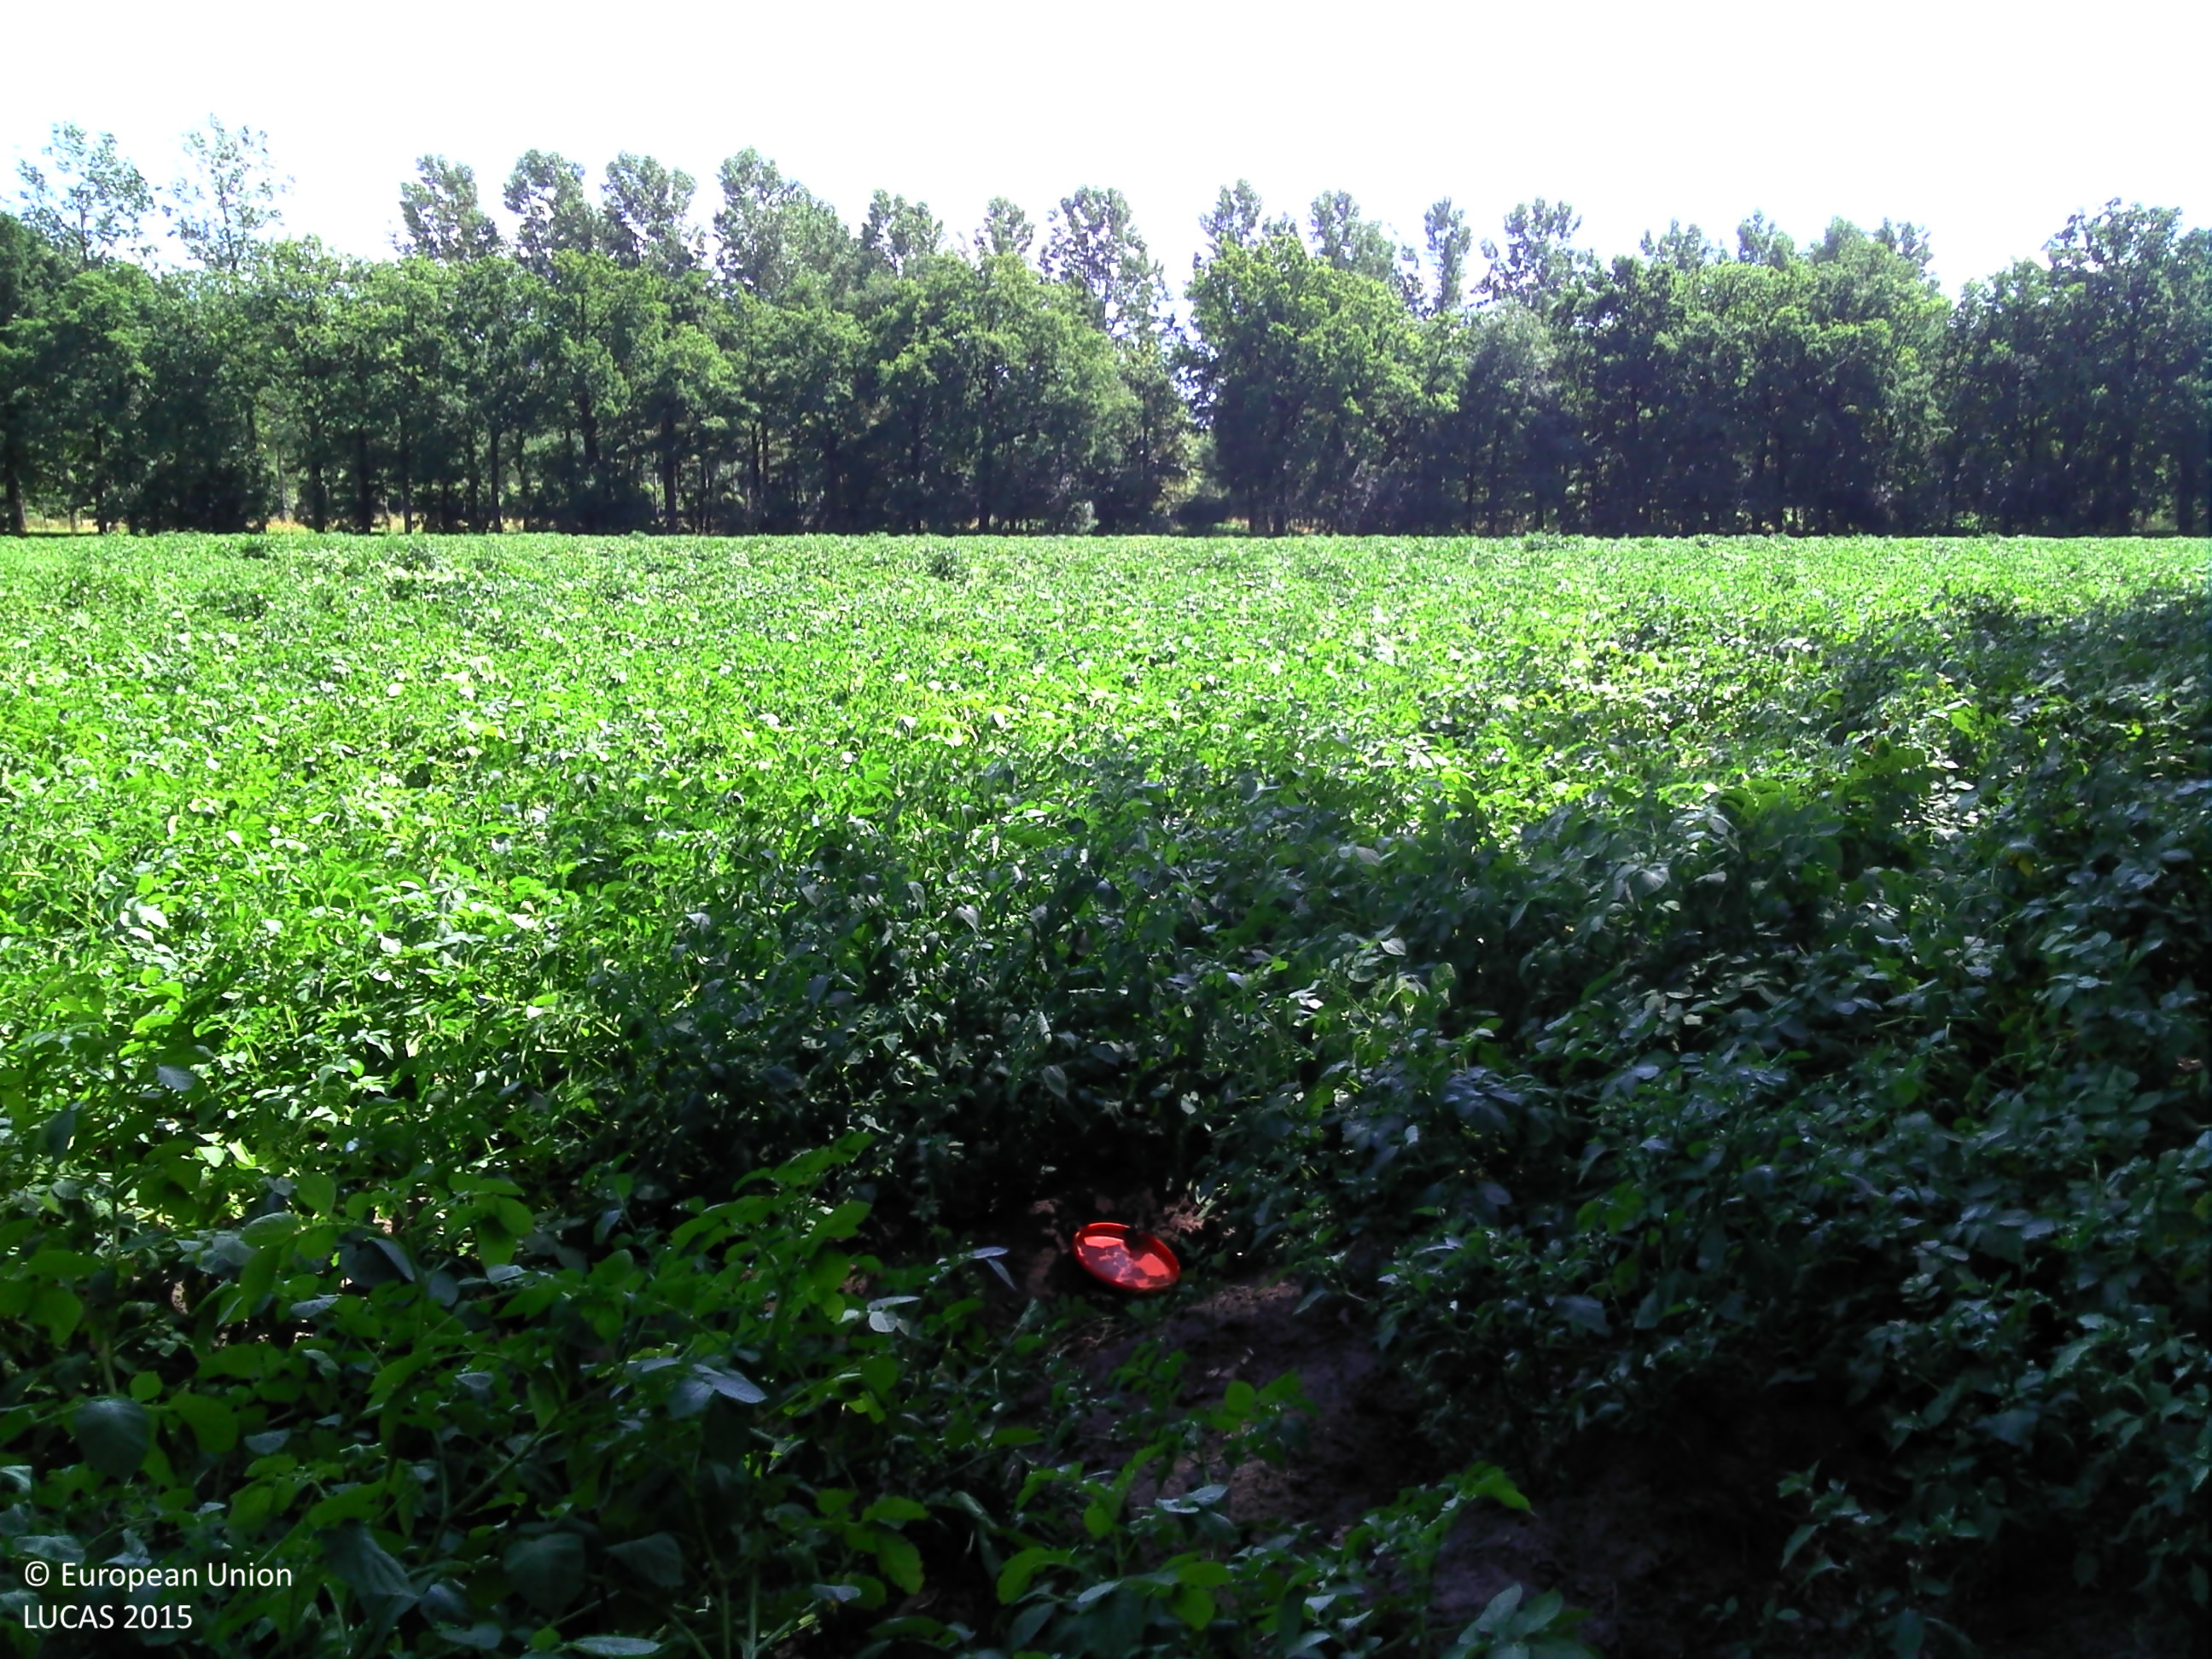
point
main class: Cropland
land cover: Potatoes
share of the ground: > 75 %
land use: Agriculture (excluding fallow land and kitchen gardens)
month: August
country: BE
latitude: 51.2317
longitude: 5.5443
